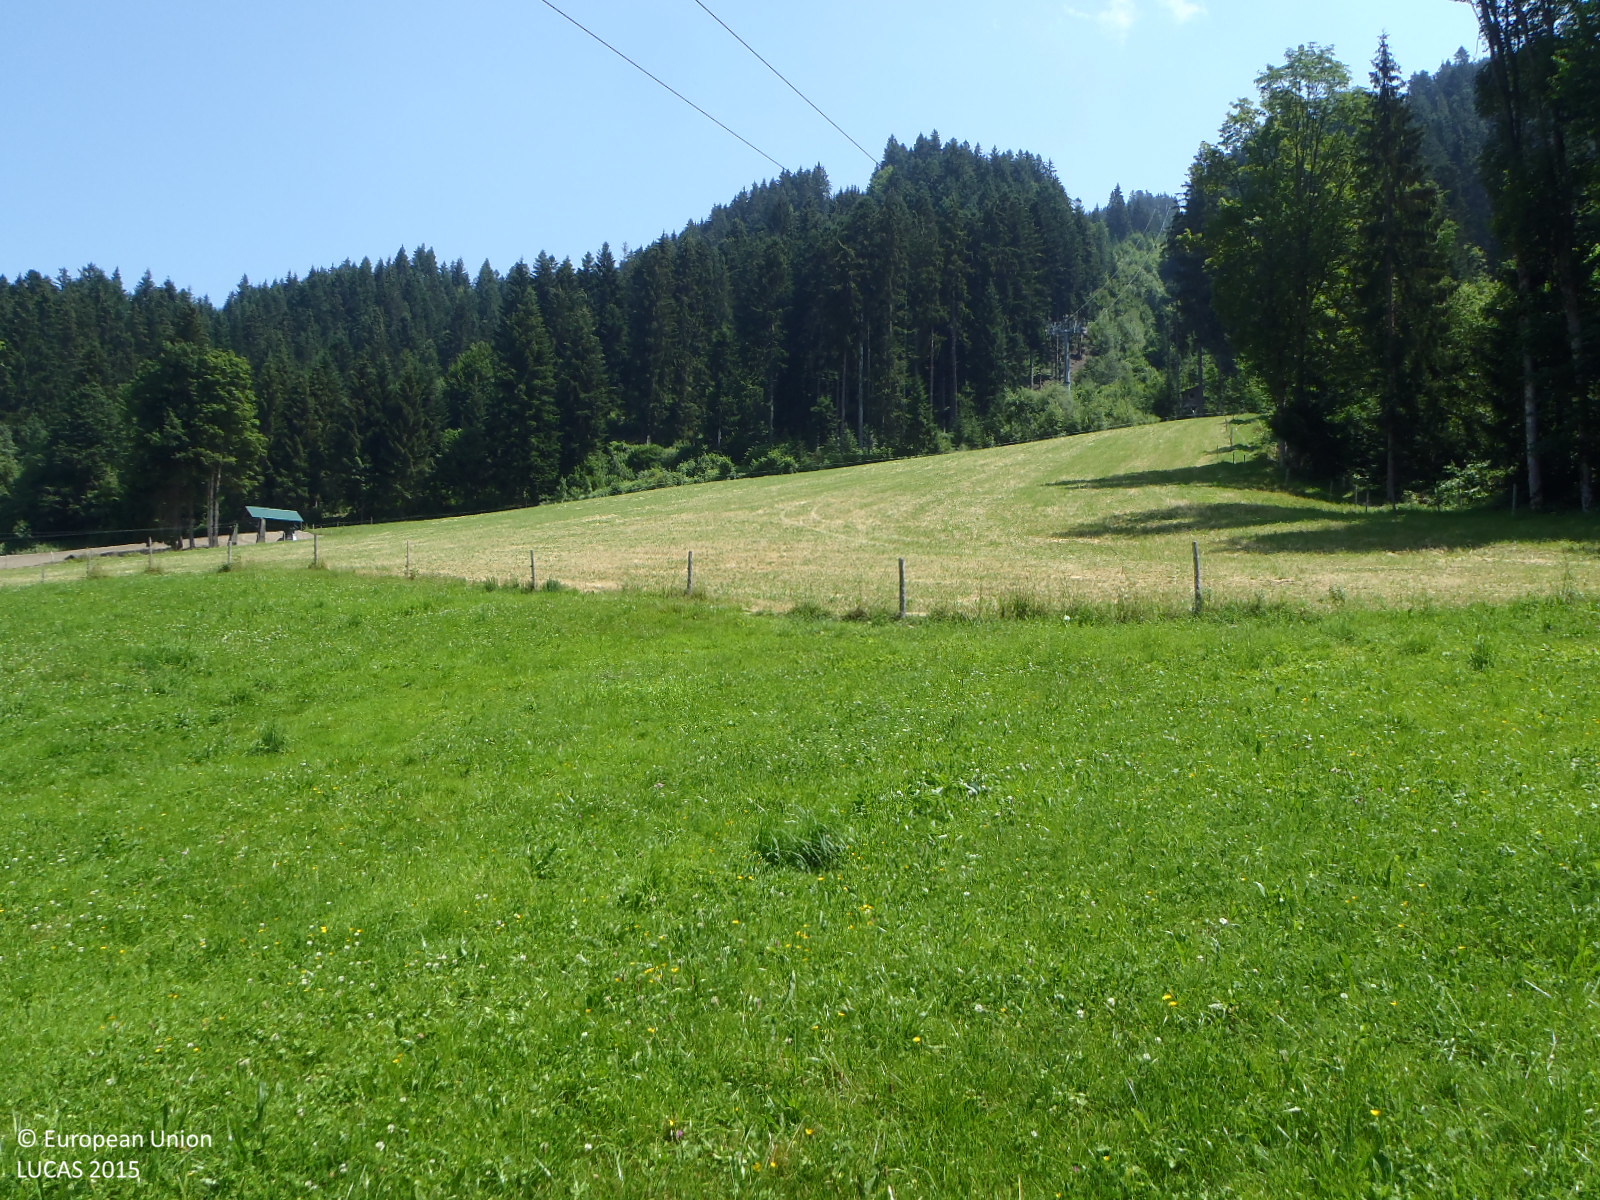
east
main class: Grassland
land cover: Grassland without tree/shrub cover
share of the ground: > 75 %
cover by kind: herbaceous plants 100 %
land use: Agriculture (excluding fallow land and kitchen gardens)
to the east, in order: Grassland without tree/shrub cover; Fences; Grassland without tree/shrub cover; Electric lines; Grassland without tree/shrub cover; Fences; Tracks; Spruce dominated mixed woodland; Other coniferous woodland; Tracks; Other coniferous woodland; Other mixed woodland
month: July
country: AT
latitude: 47.4952
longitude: 12.4009
